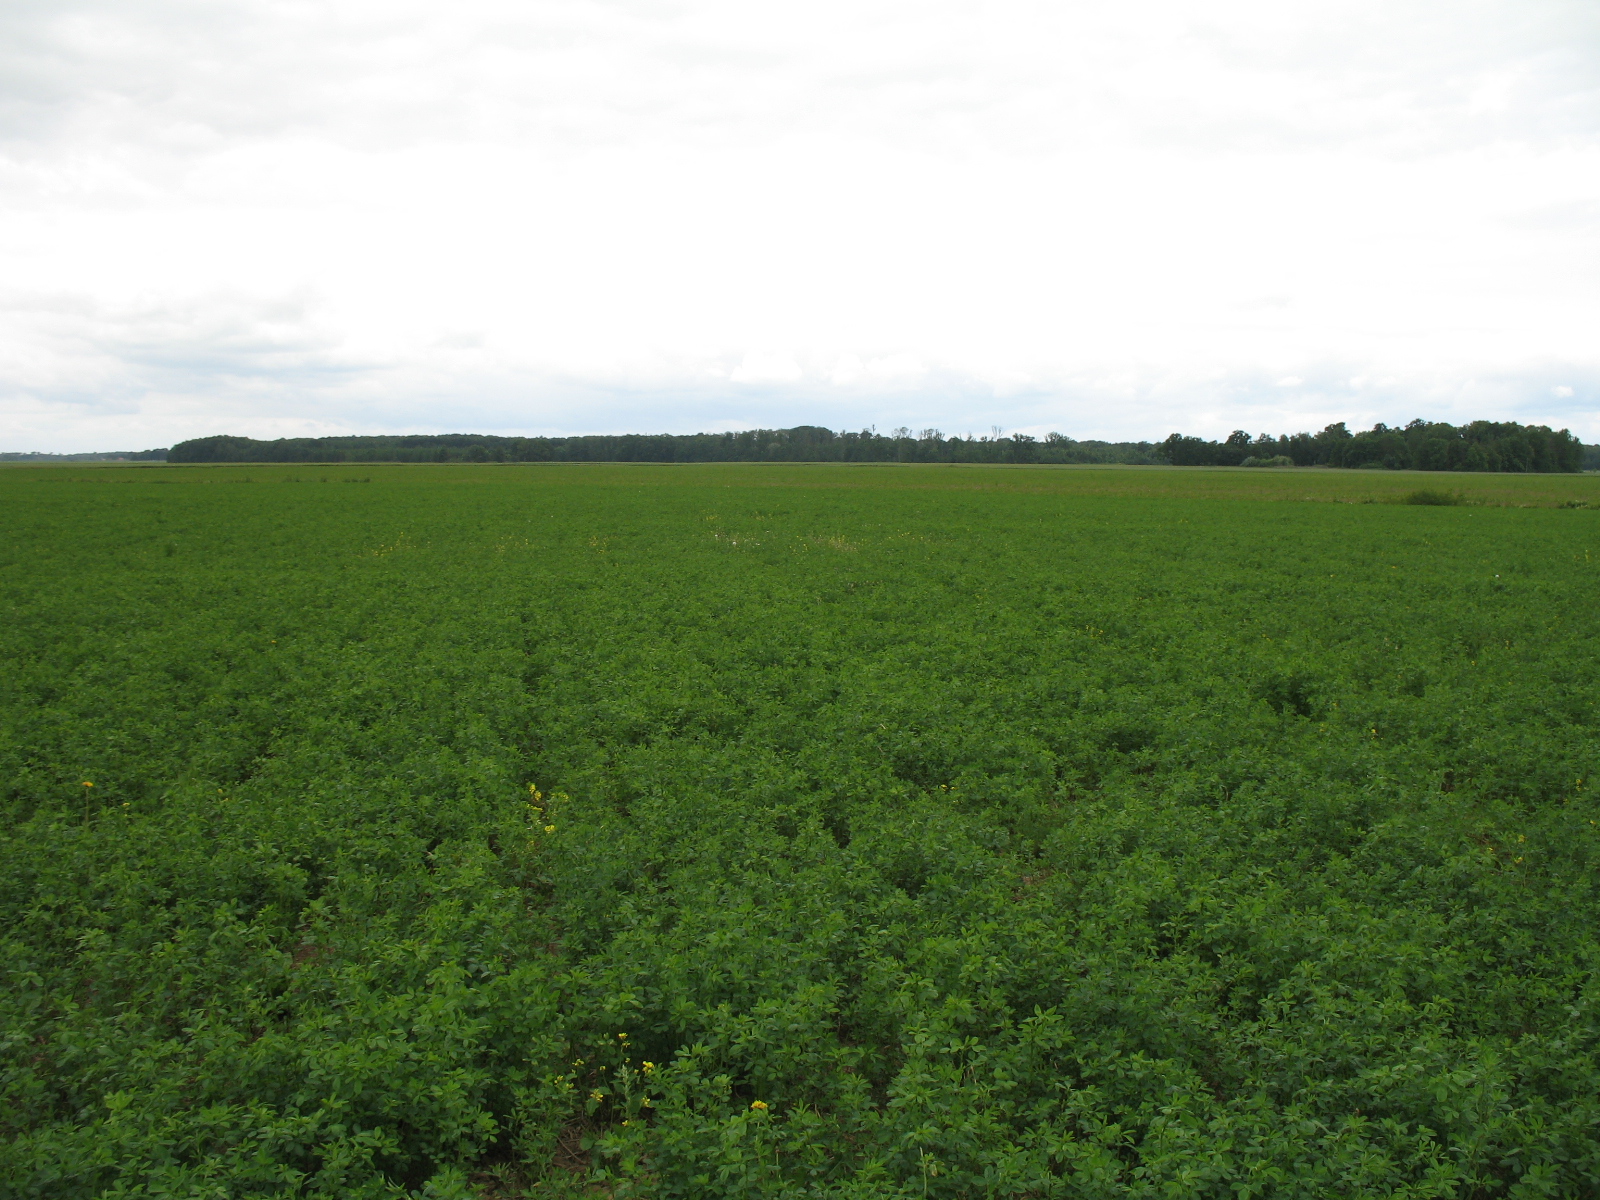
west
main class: Cropland
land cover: Lucerne
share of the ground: > 75 %
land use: Agriculture (excluding fallow land and kitchen gardens)
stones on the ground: < 10 %
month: June
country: LV
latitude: 56.5480
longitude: 23.4941
